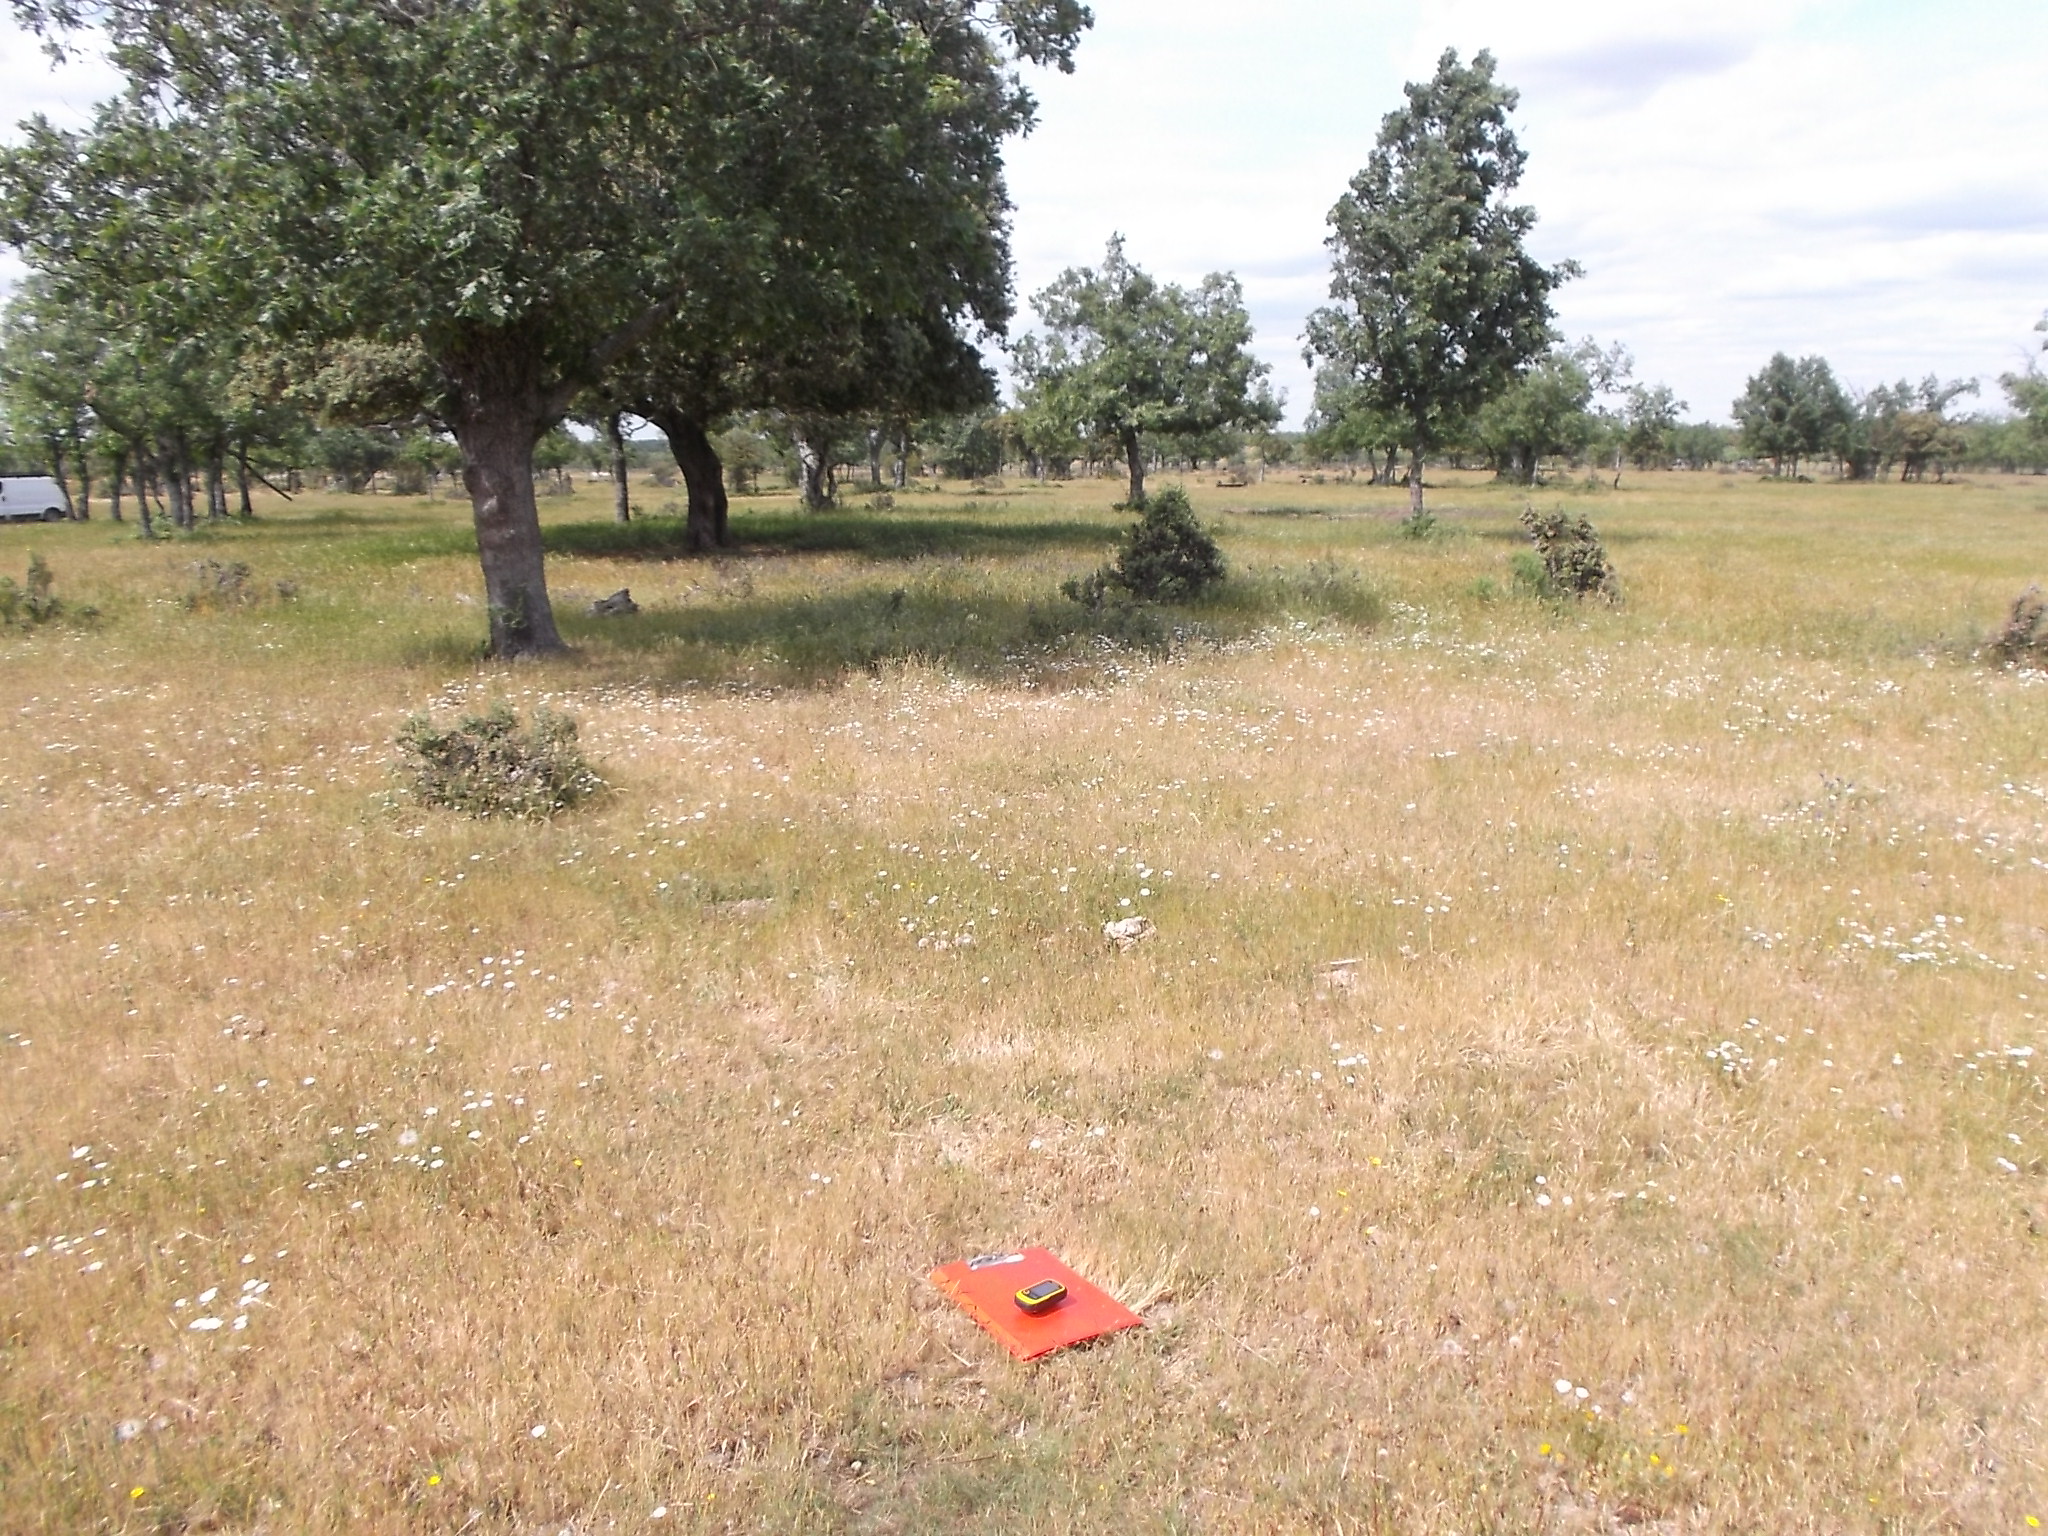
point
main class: Grassland
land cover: Grassland with sparse tree/shrub cover
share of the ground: > 75 %
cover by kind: herbaceous plants 90 %, broadleaved forest trees 5 %, shrubs 5 %
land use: Agriculture (excluding fallow land and kitchen gardens)
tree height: < 5 m
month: May
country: ES
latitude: 41.1205
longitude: -6.3025
